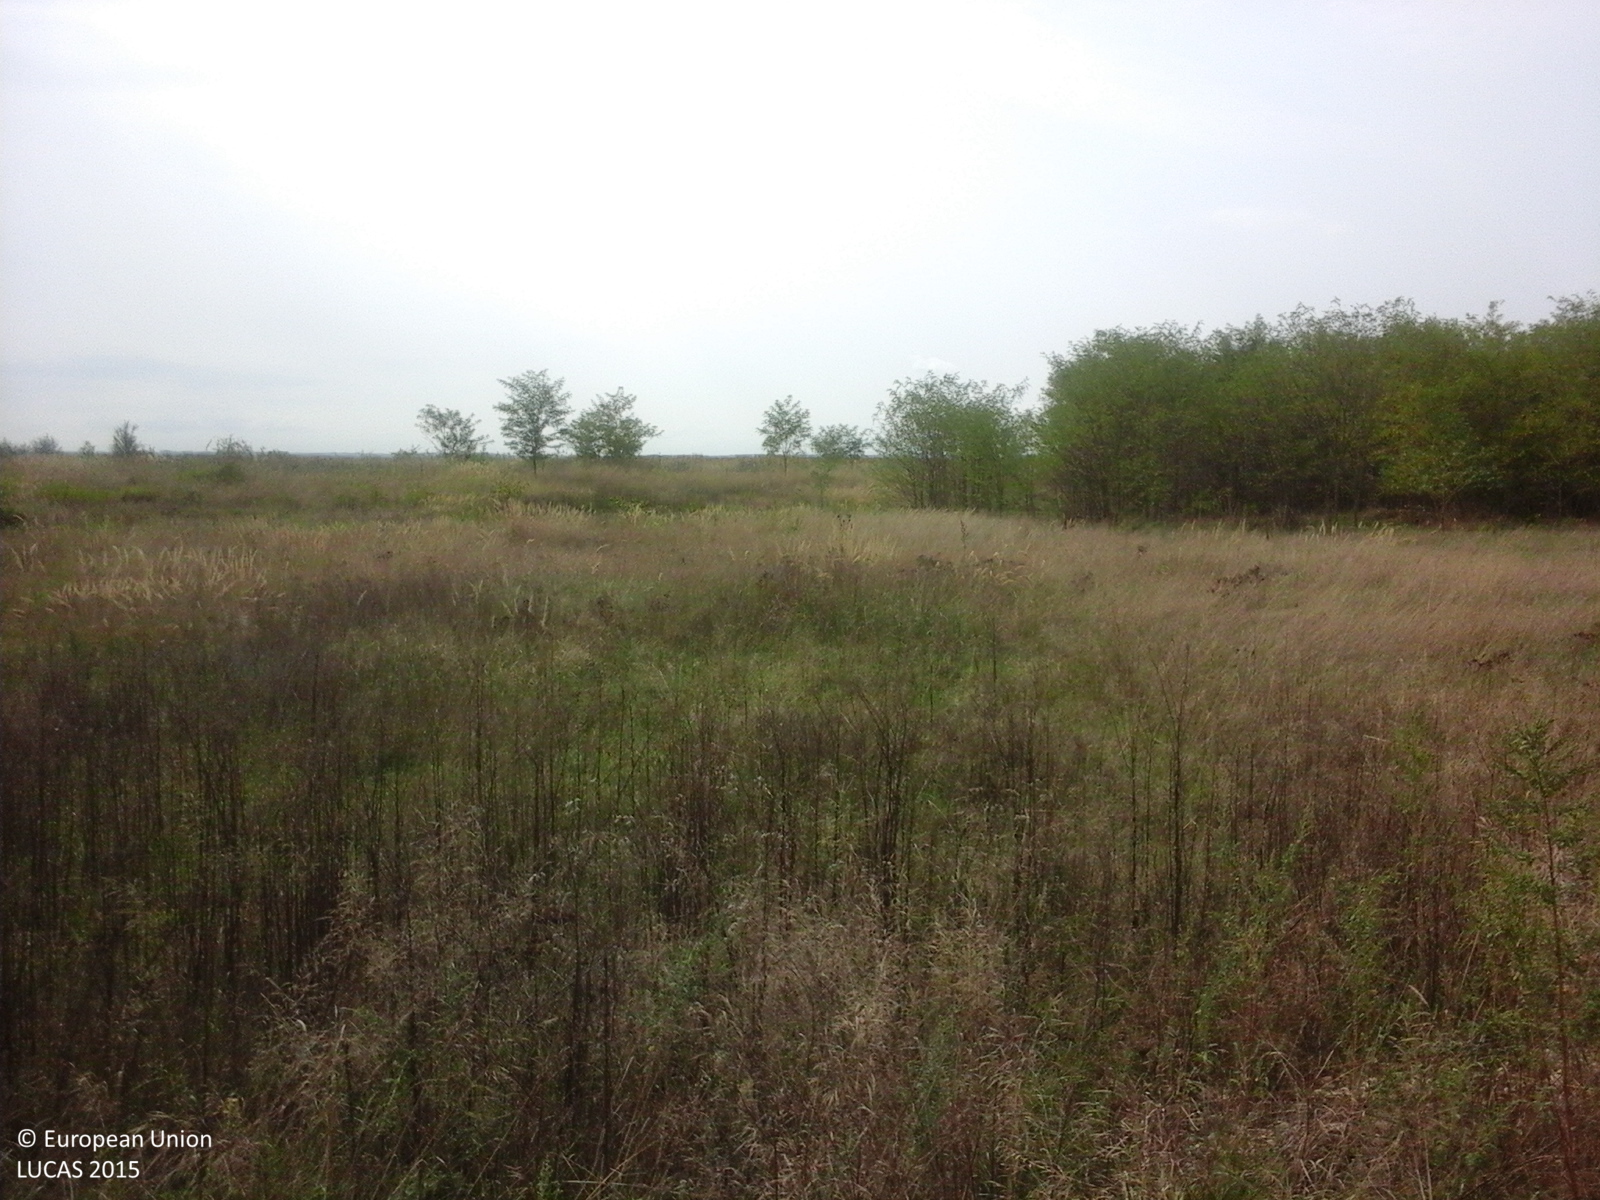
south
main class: Grassland
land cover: Spontaneously vegetated surfaces
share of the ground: 50 - 75 %
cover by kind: herbaceous plants 75 %, unconsolidated bare surface 25 %
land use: Mining and quarrying
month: September
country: RO
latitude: 45.6562
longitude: 21.9870
